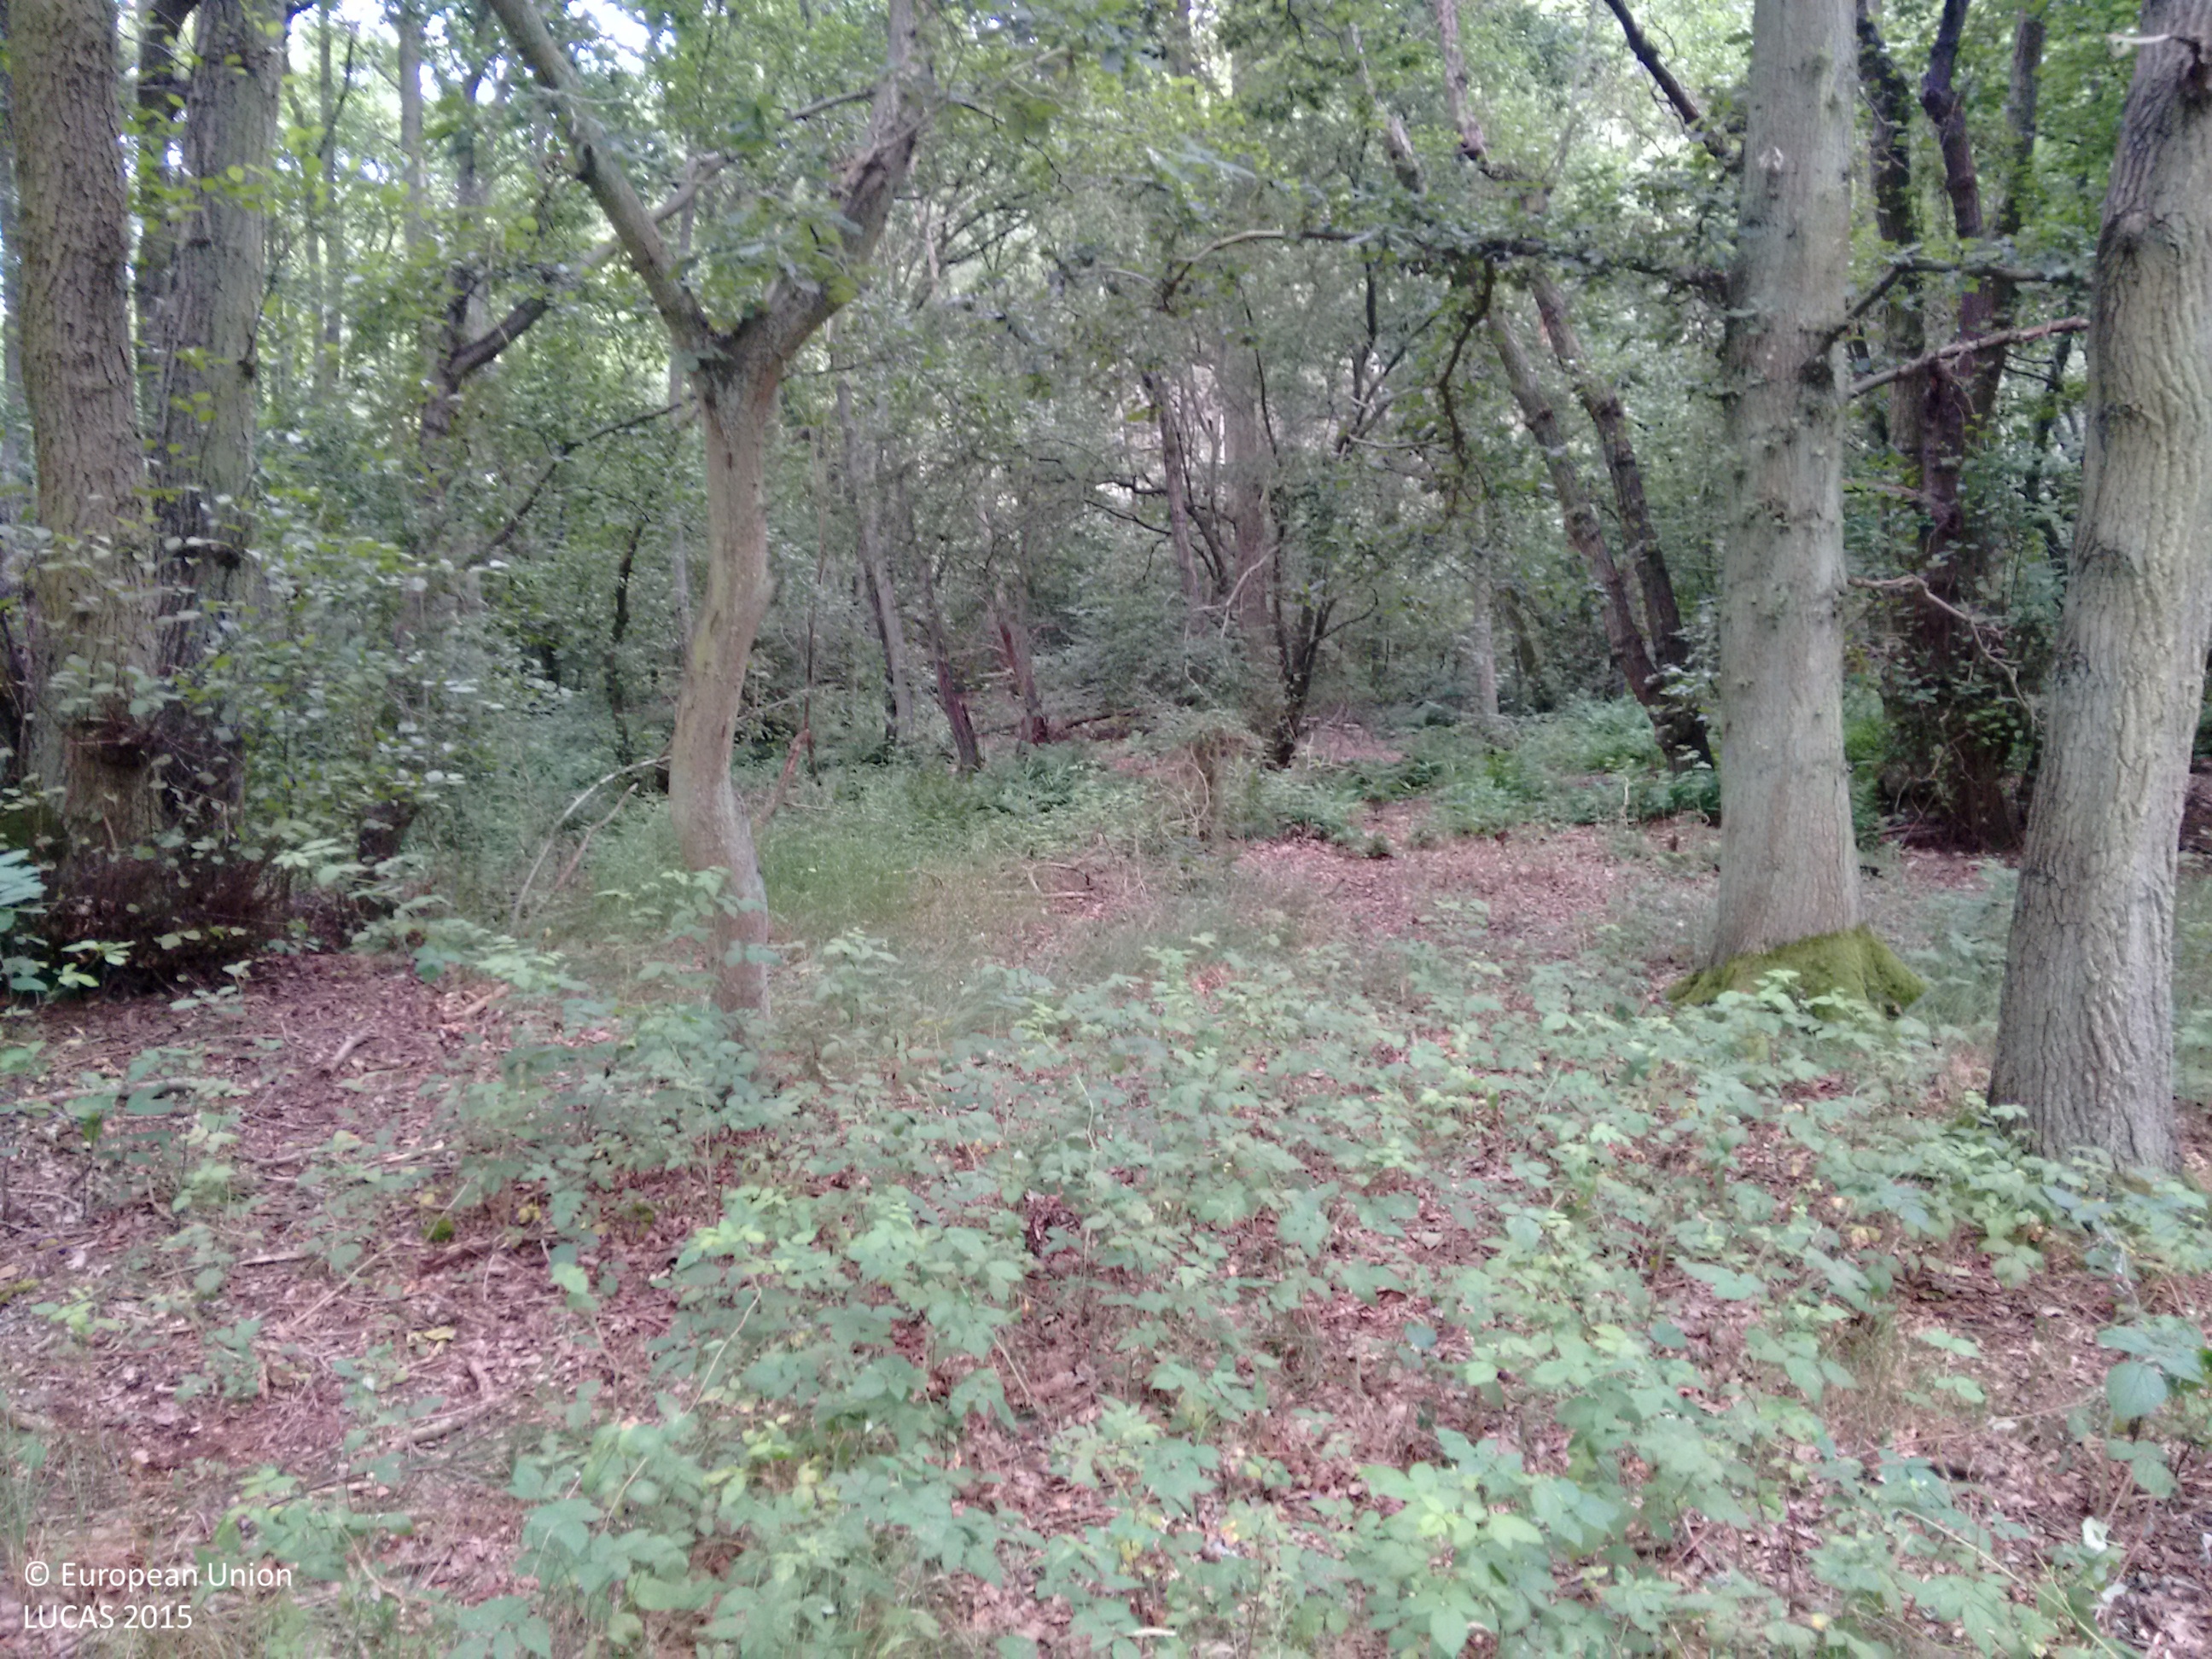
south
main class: Woodland
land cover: Broadleaved woodland
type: mesophytic deciduous forest
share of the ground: > 75 %
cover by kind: broadleaved forest trees 100 %
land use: Amenities, museums, leisure
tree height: > 5 m
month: August
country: GB
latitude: 52.3603
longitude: 0.5307
